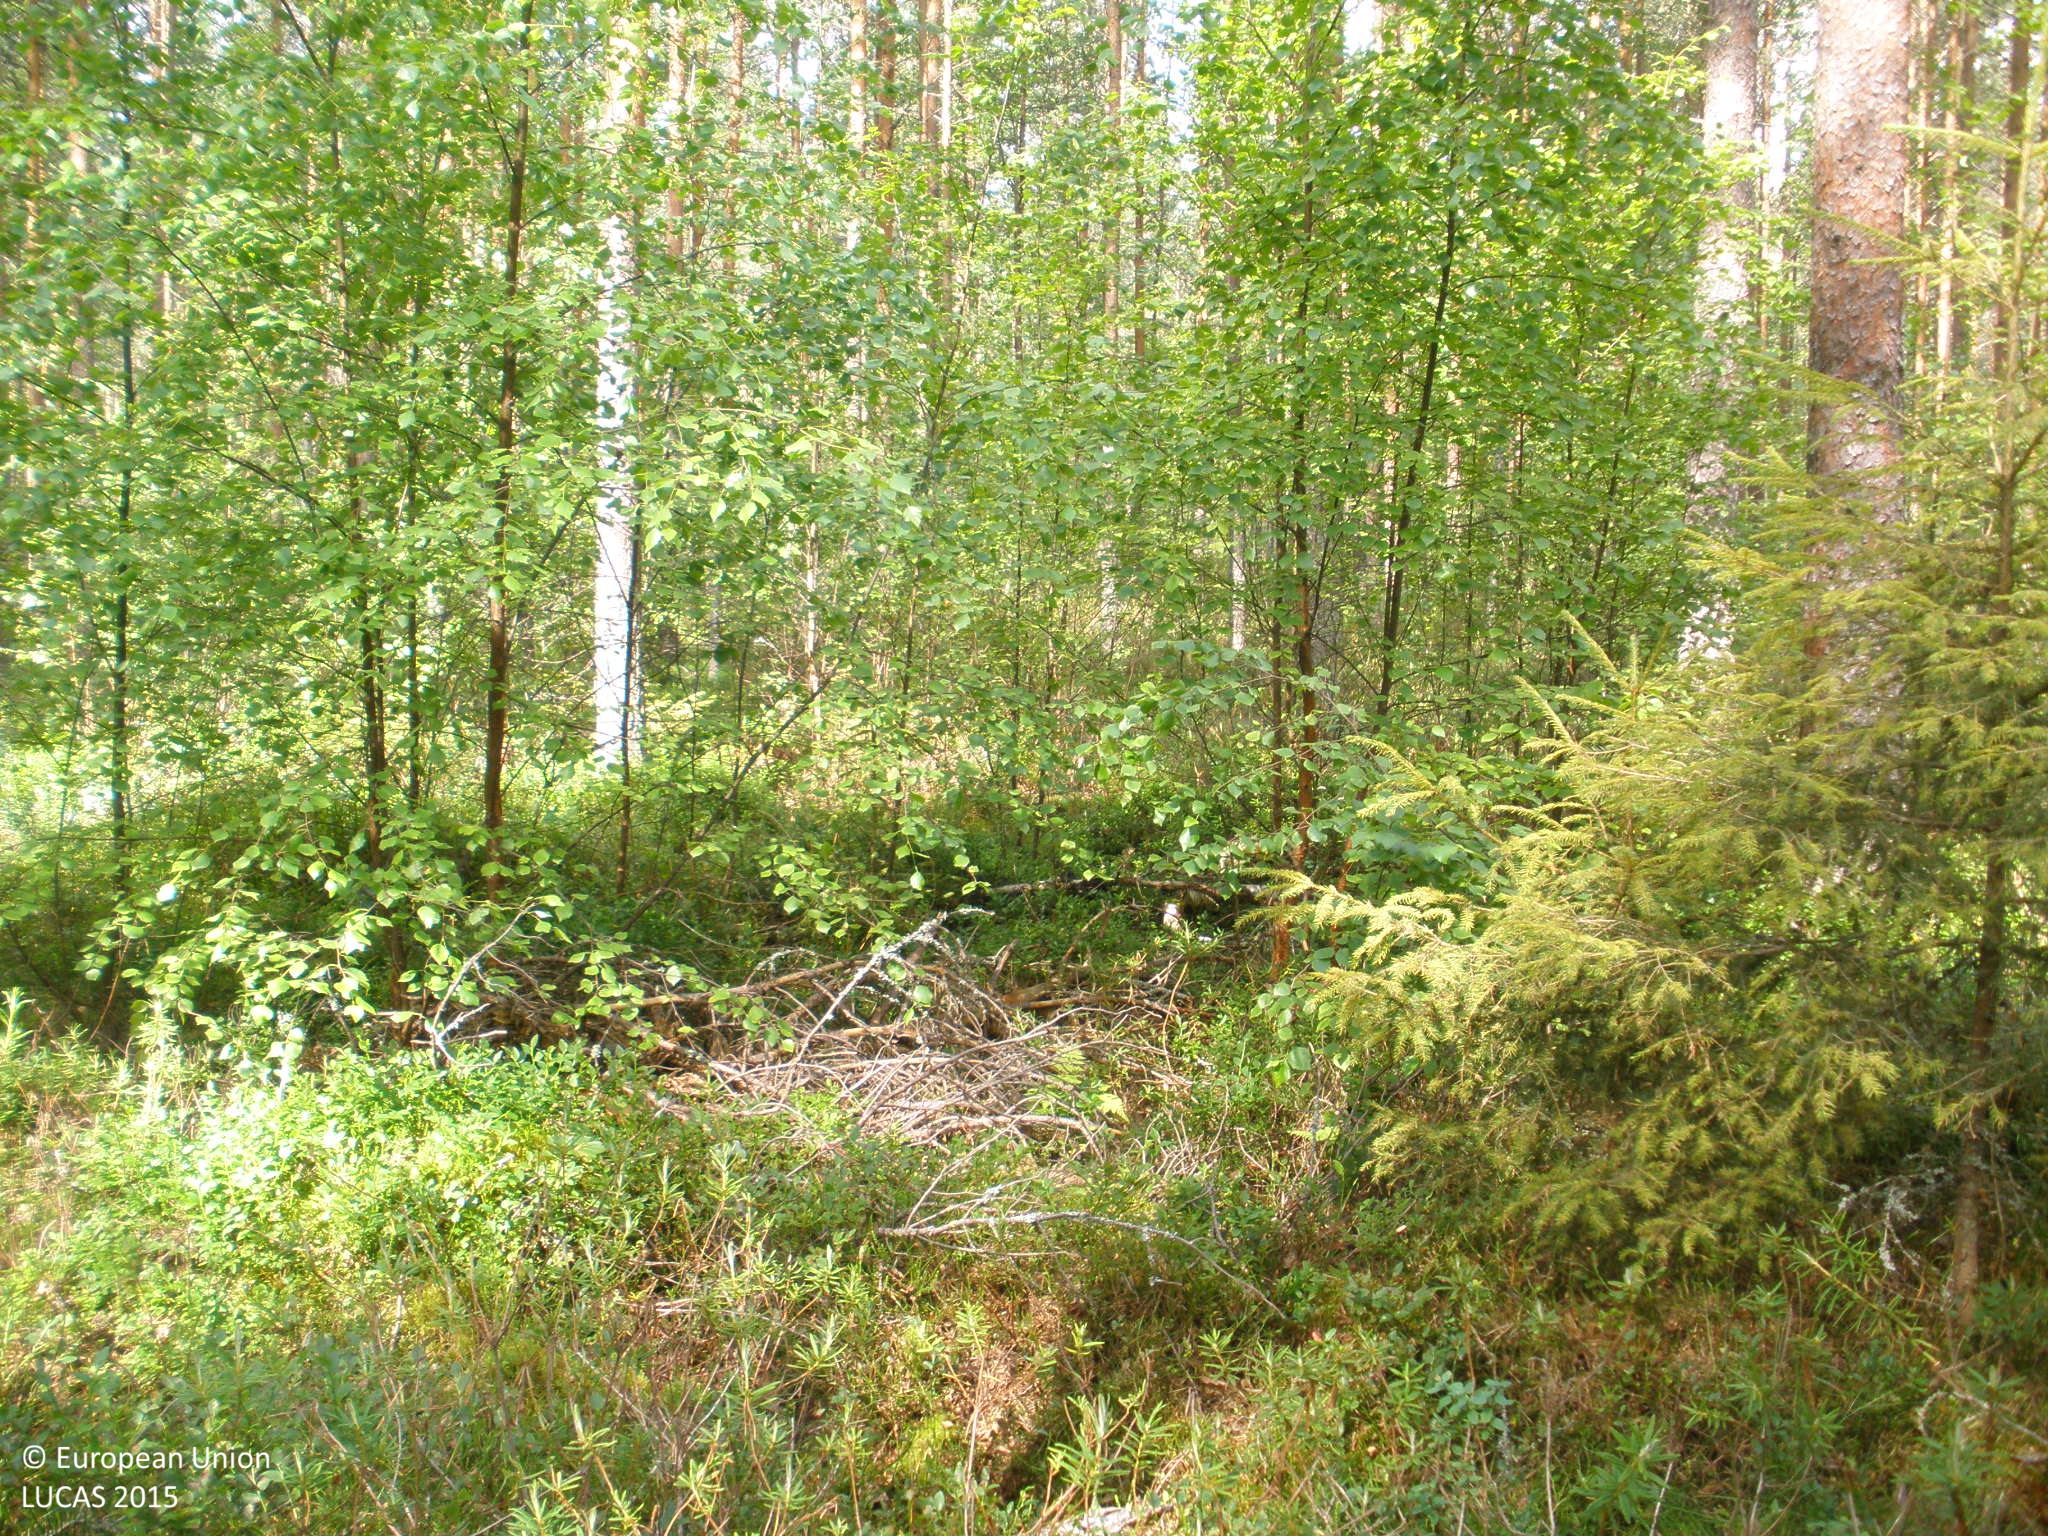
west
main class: Woodland
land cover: Pine dominated mixed woodland
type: boreal forest
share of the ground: > 75 %
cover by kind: coniferous forest trees 60 %, broadleaved forest trees 25 %, lichens and mosses 10 %, herbaceous plants 5 %
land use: Forestry
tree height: > 5 m
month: July
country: FI
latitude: 61.1868
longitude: 25.0490
